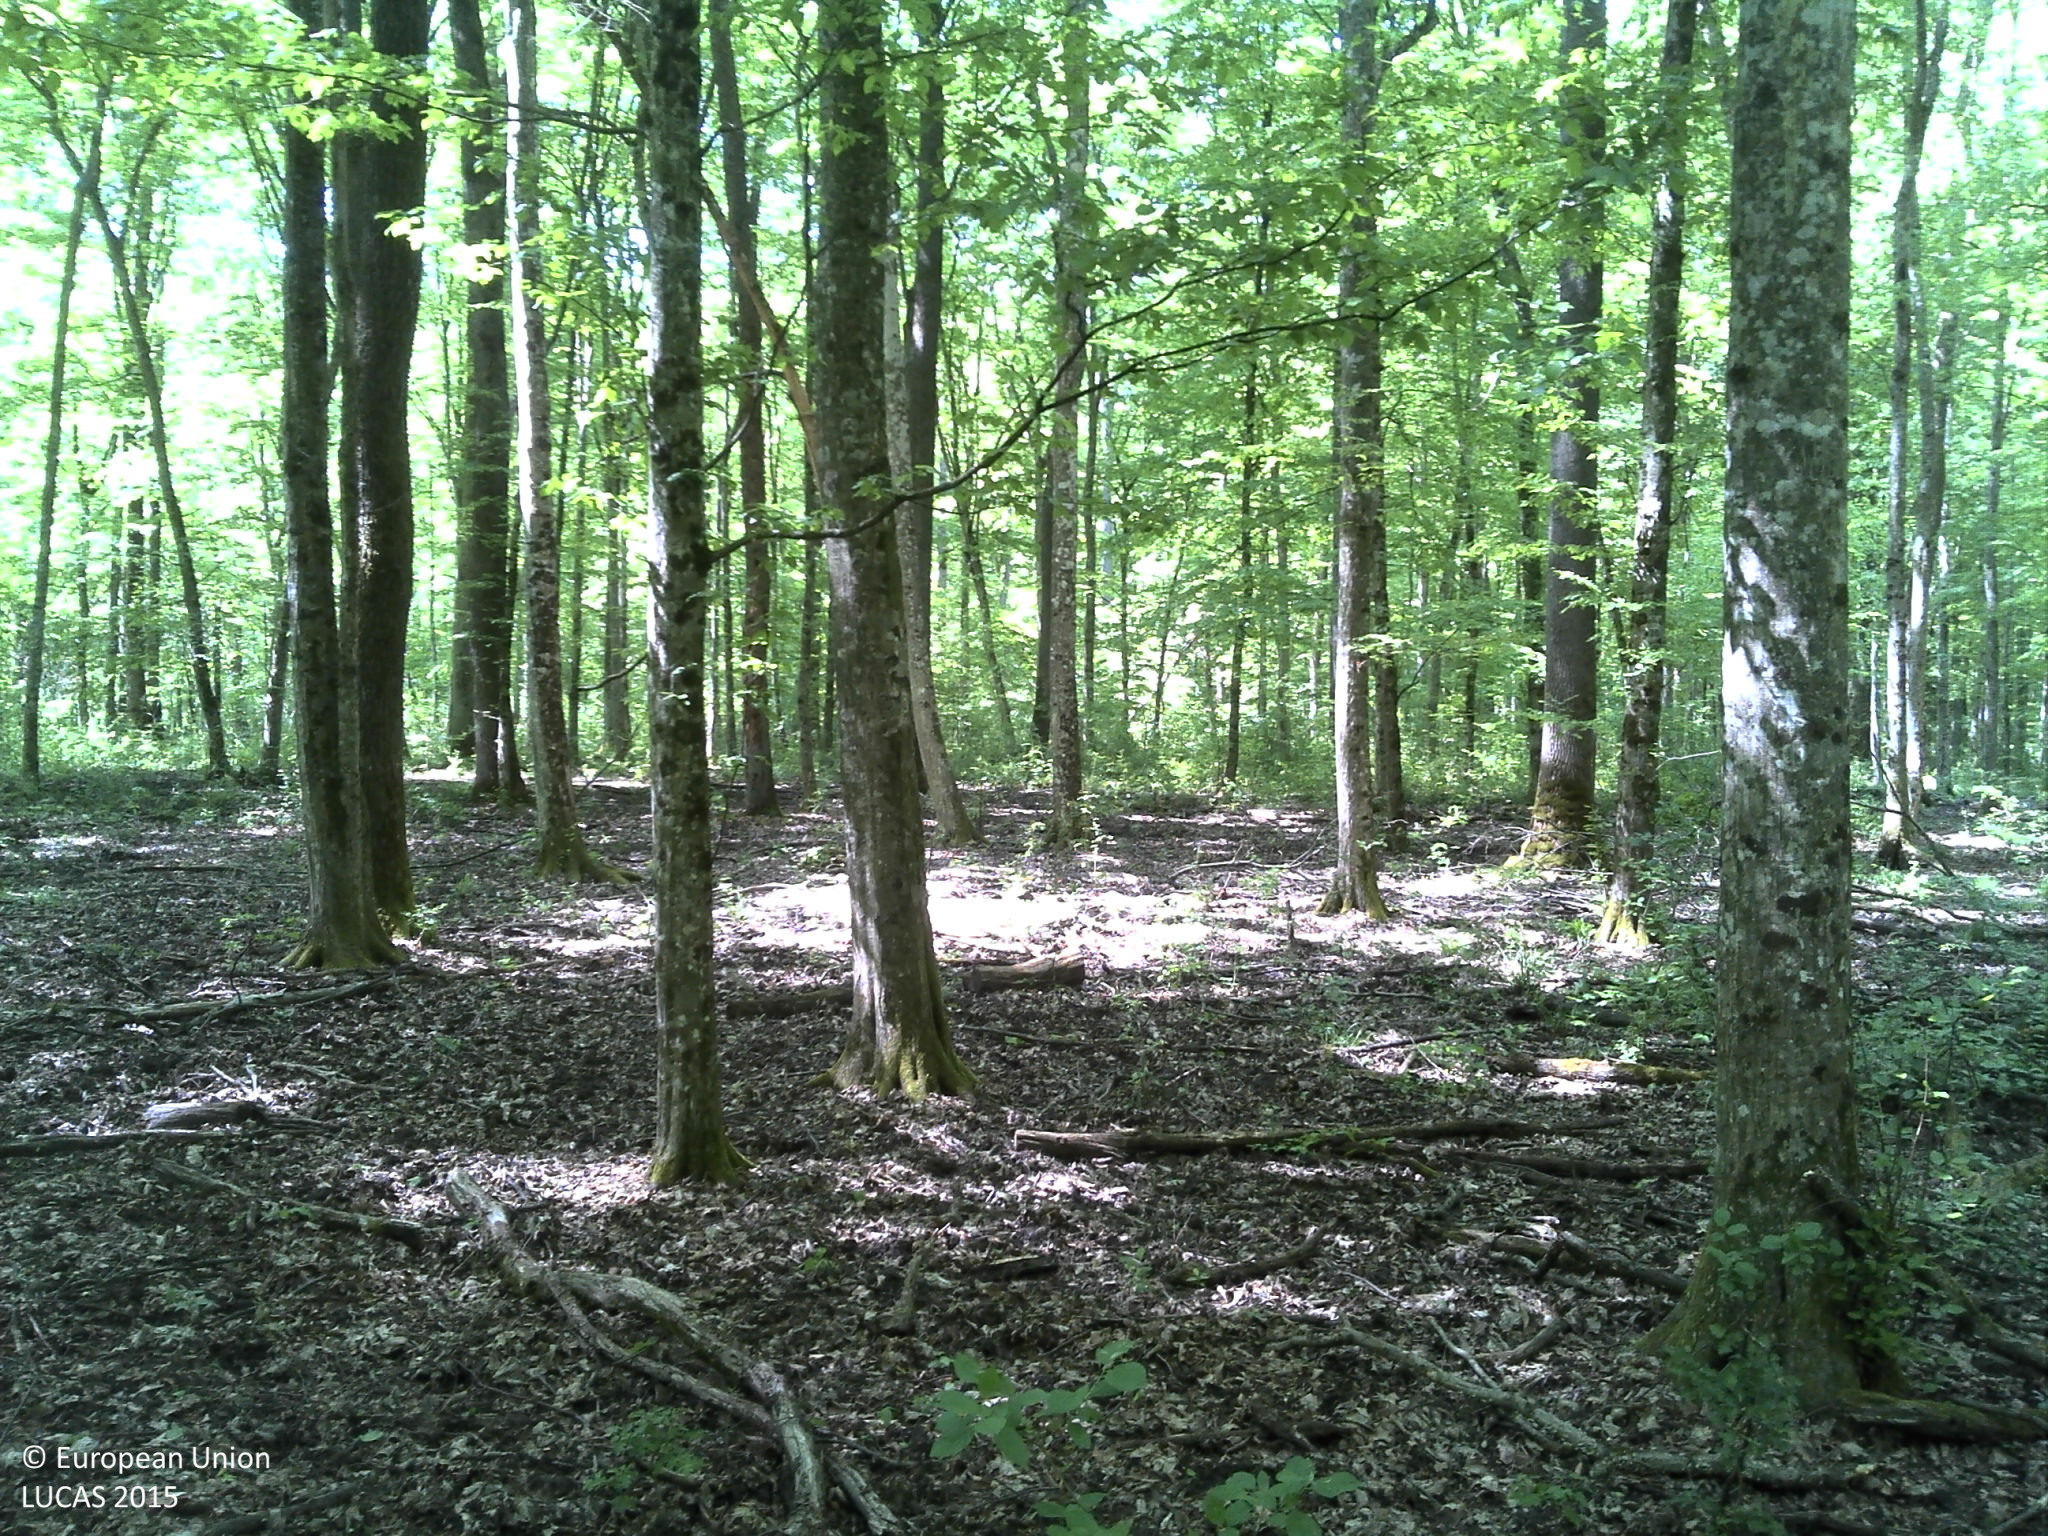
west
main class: Woodland
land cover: Broadleaved woodland
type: mesophytic deciduous forest
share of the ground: > 75 %
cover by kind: broadleaved forest trees 100 %
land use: Forestry
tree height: > 5 m
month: April
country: HR
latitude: 45.0504
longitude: 18.9585
